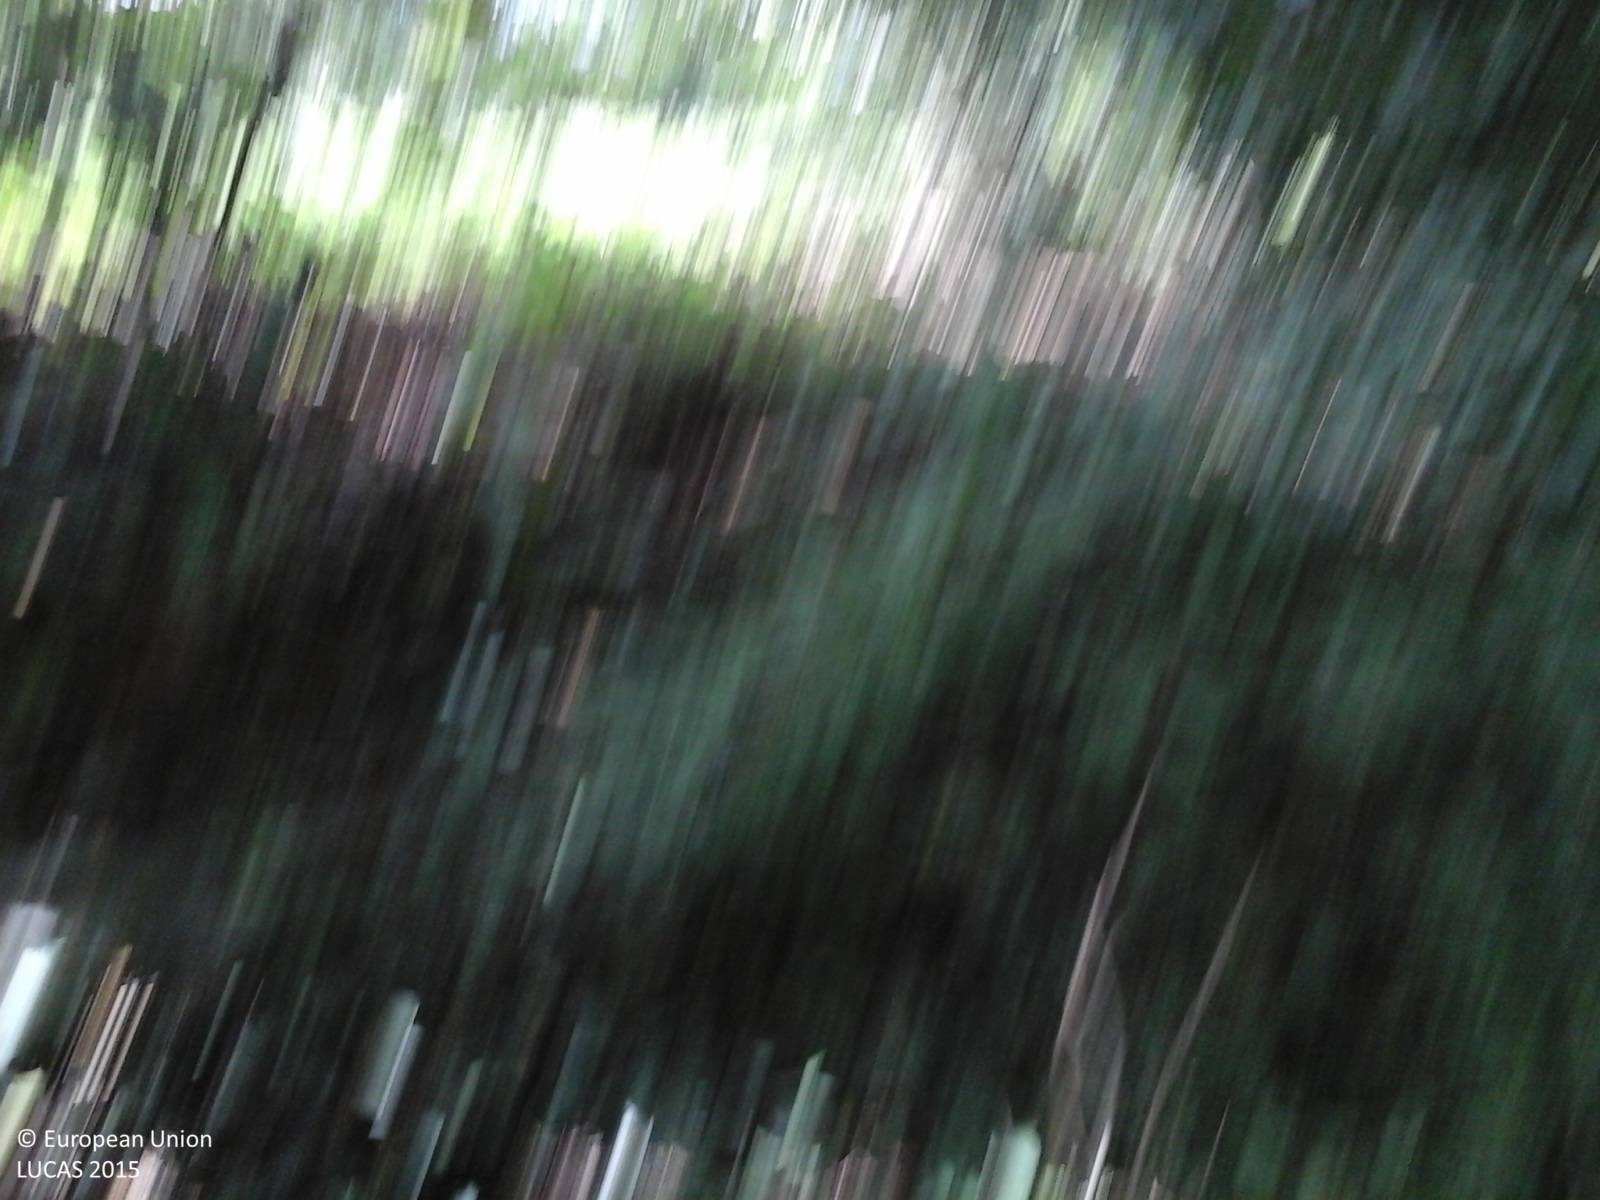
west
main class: Woodland
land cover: Broadleaved woodland
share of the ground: > 75 %
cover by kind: broadleaved forest trees 80 %, shrubs 20 %
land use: Forestry
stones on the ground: < 10 %
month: September
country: IT
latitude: 42.9757
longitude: 12.0905
